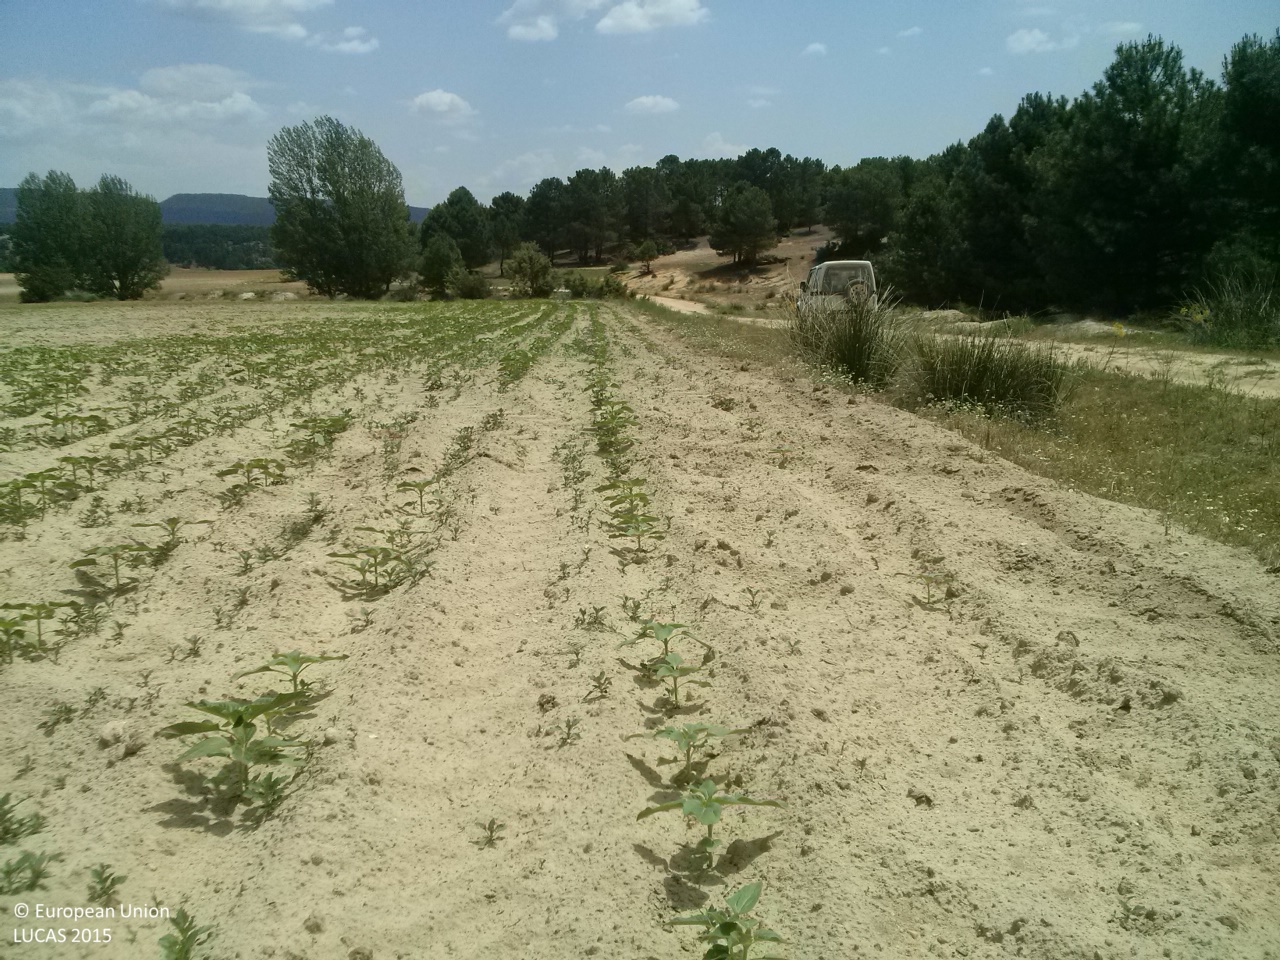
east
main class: Cropland
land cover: Sunflower
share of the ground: < 10 %
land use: Agriculture (excluding fallow land and kitchen gardens)
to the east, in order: Sunflower; Grassland with sparse tree/shrub cover; Tracks; Grass margins; Pine dominated coniferous woodland; Sunflower
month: June
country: ES
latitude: 39.9573
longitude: -1.7759
